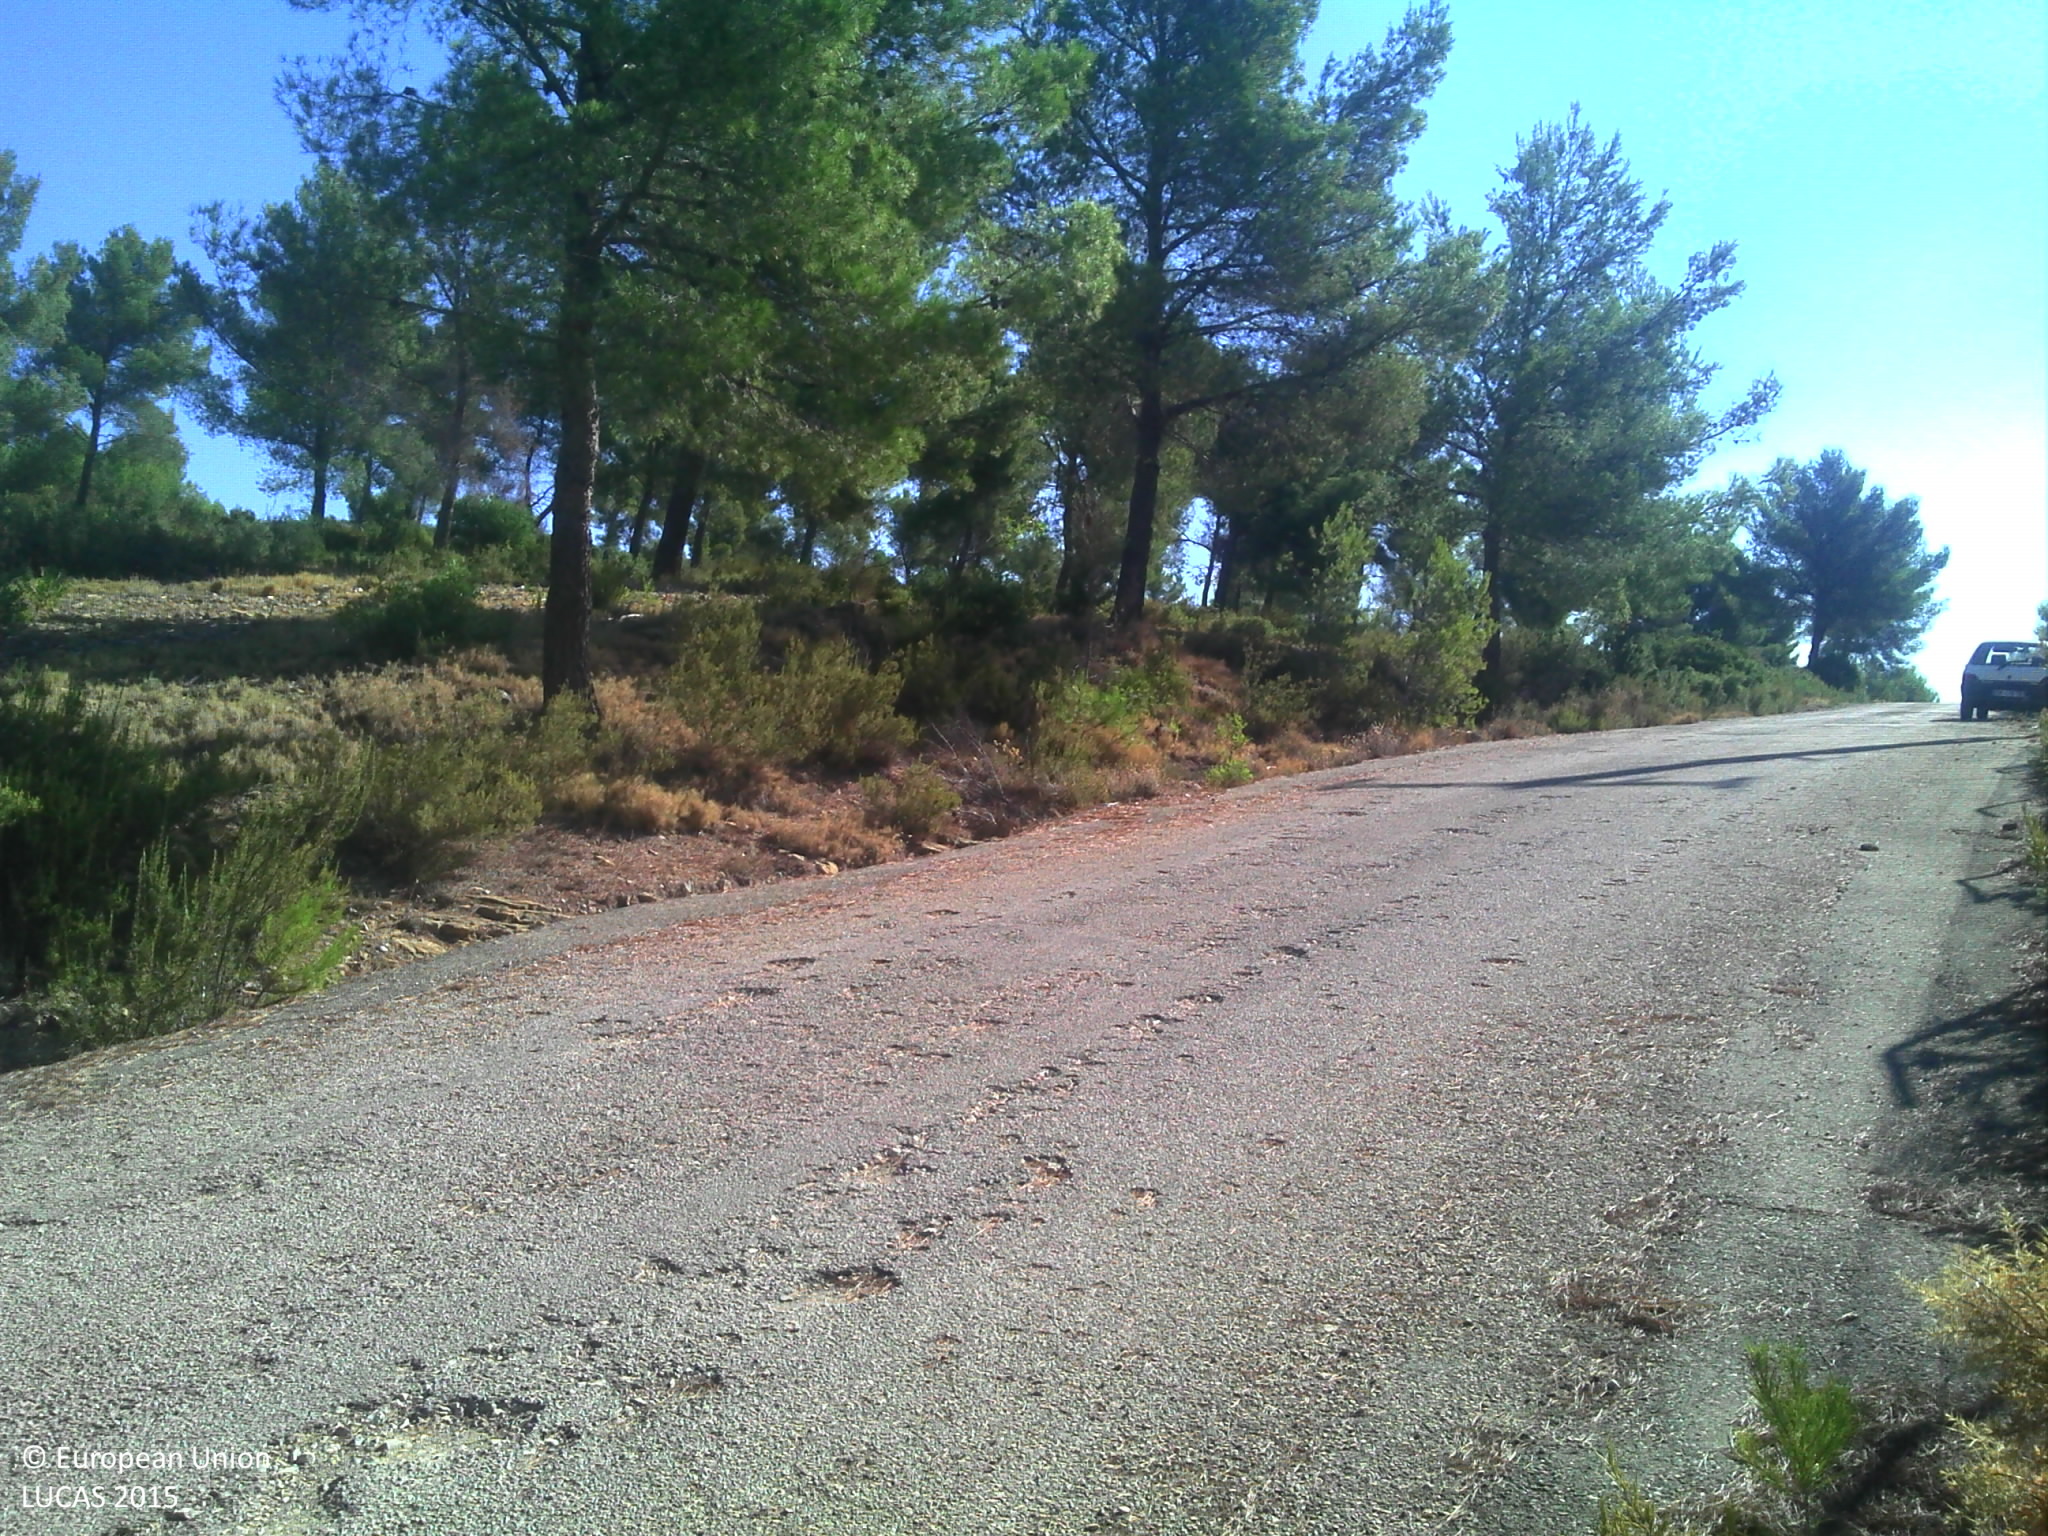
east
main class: Woodland
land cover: Pine dominated coniferous woodland
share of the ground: > 75 %
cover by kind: coniferous forest trees 35 %, herbaceous plants 30 %, consolidated bare surface 25 %, shrubs 10 %
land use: Road transport
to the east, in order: Pine dominated coniferous woodland; Paved roads, cycling and walking lanes; Fences; Pine dominated coniferous woodland; Tracks; Electric lines; Pine dominated coniferous woodland
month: August
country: FR
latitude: 43.1941
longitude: 5.6666
